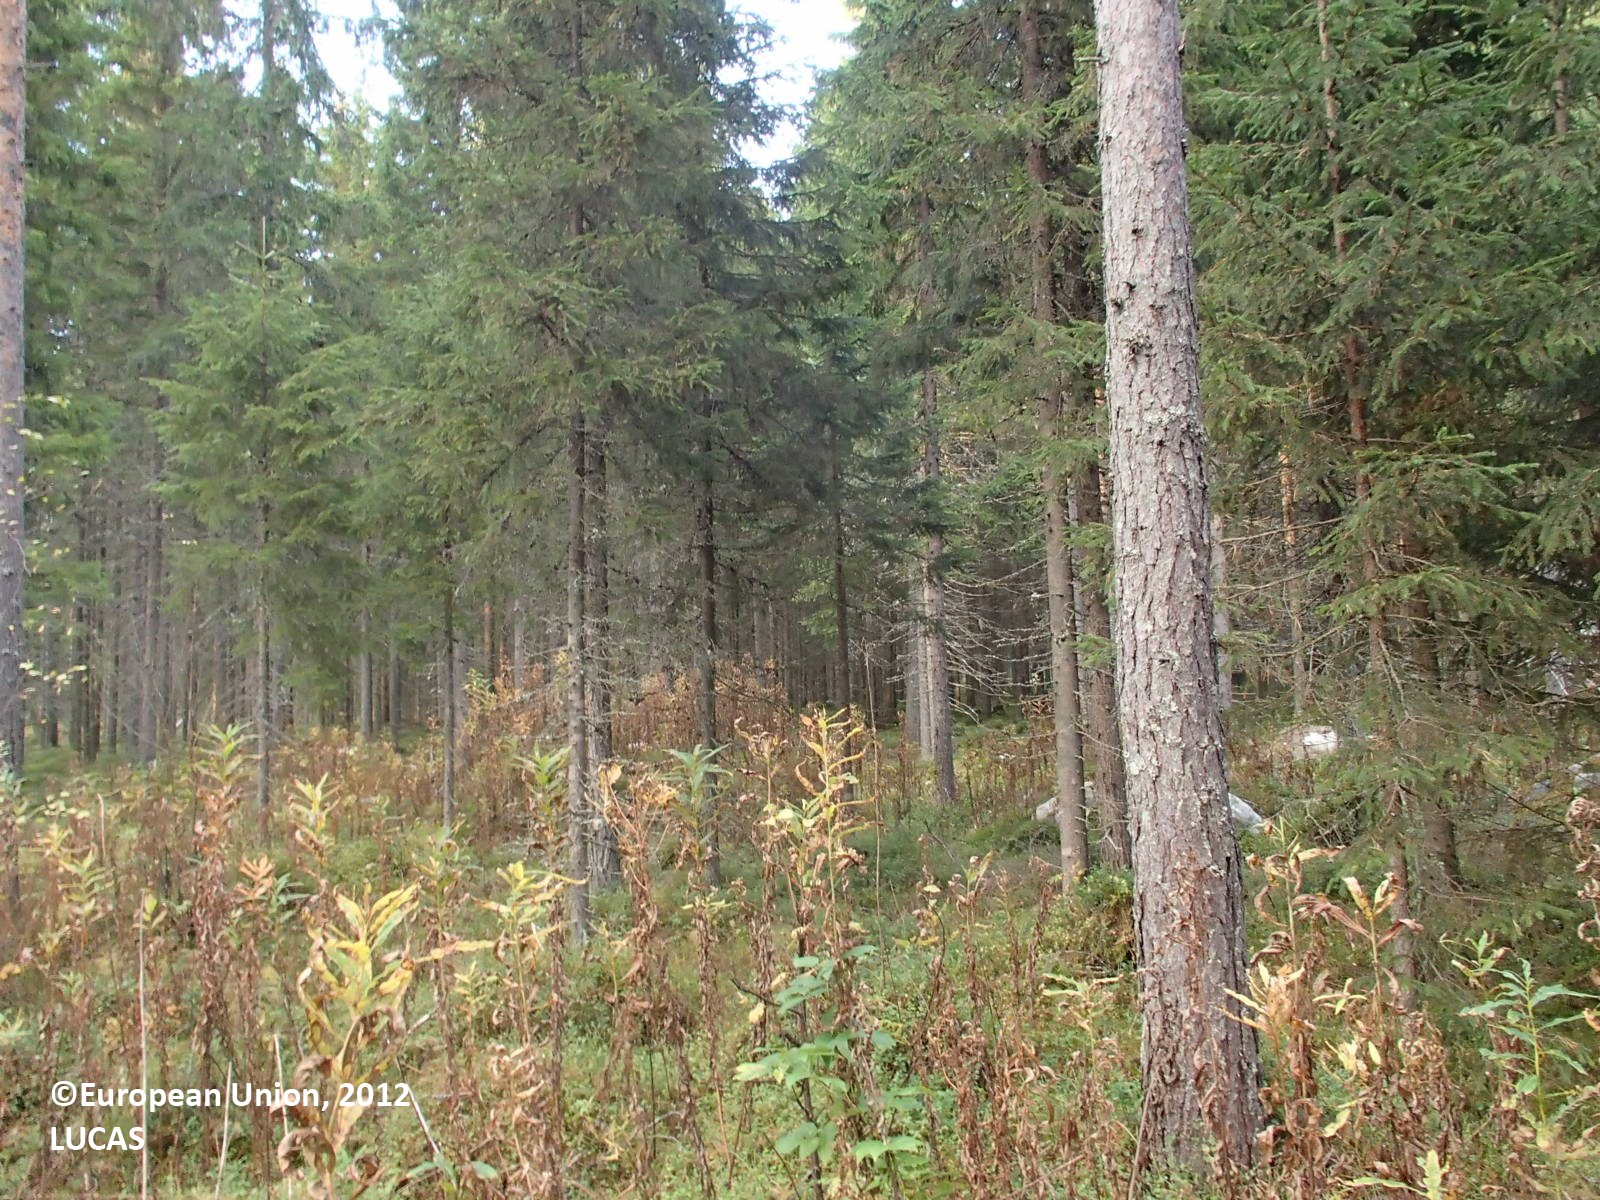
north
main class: Woodland
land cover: Spruce dominated coniferous woodland
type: boreal forest
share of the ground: > 75 %
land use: Forestry
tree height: > 5 m
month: September
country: FI
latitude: 63.5521
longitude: 26.0735
